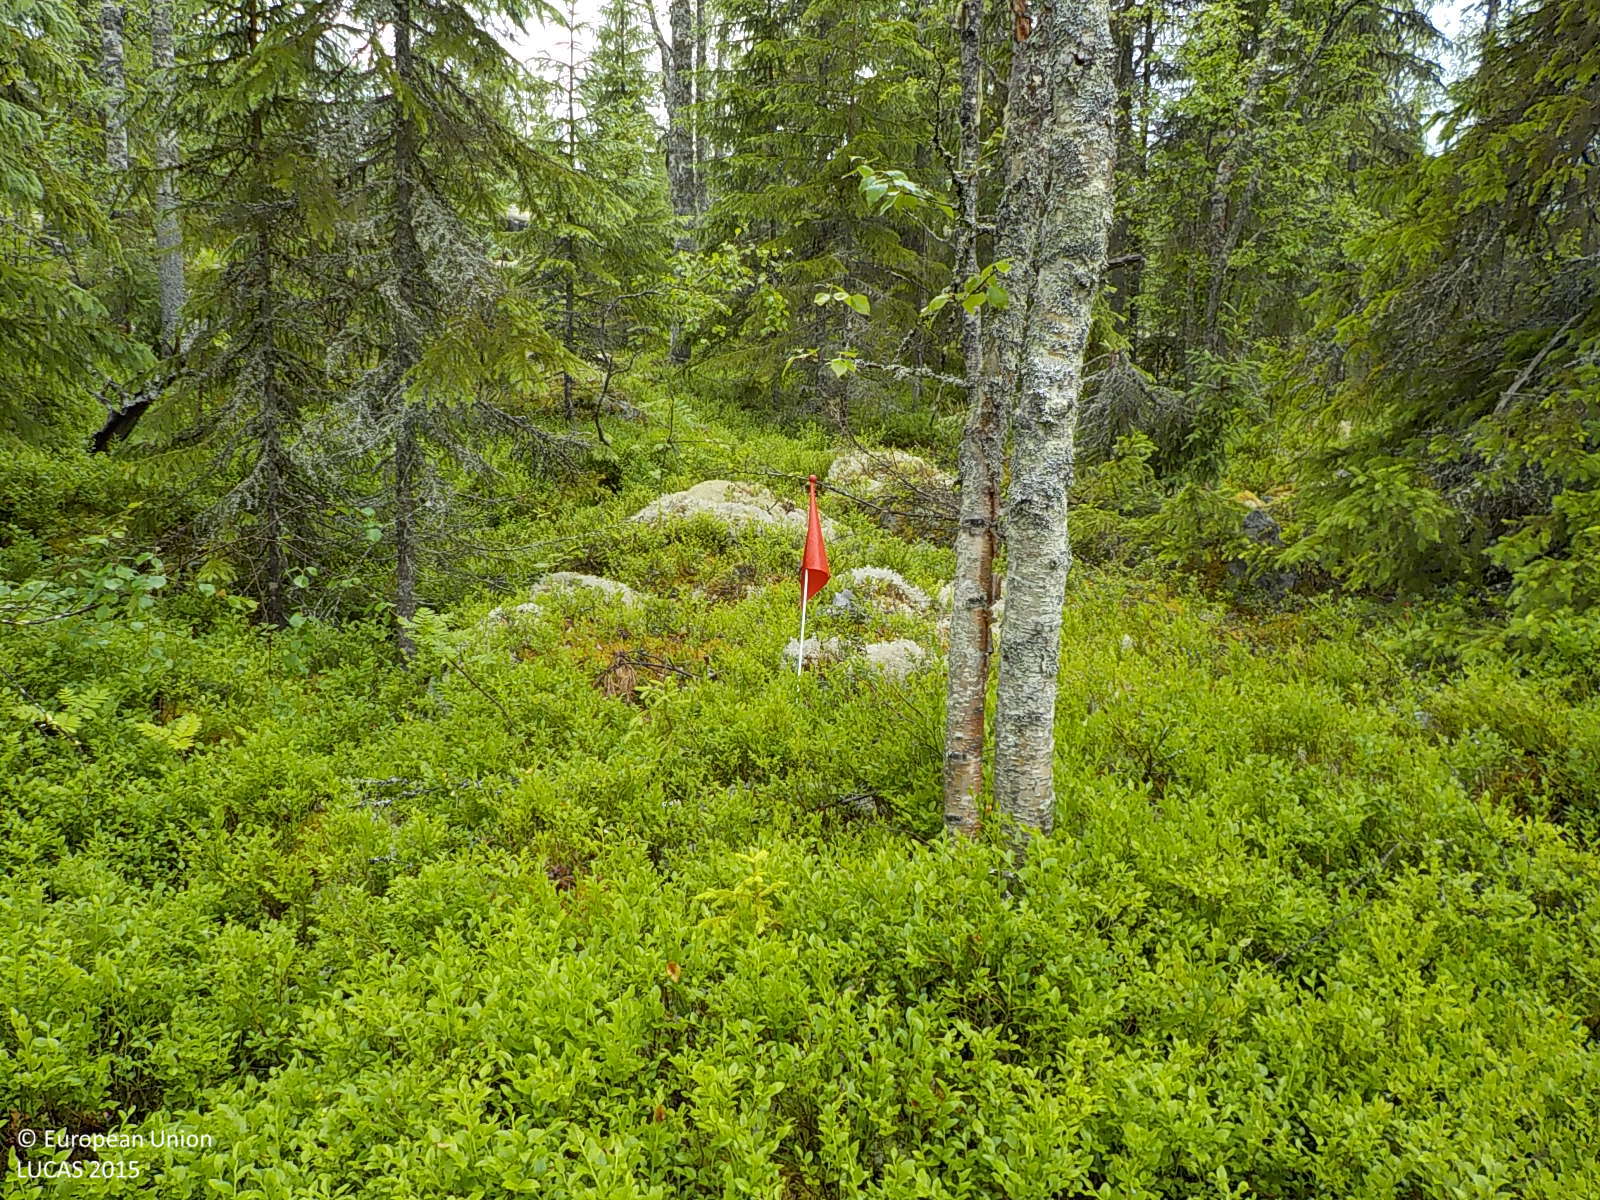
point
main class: Woodland
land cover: Spruce dominated mixed woodland
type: boreal forest
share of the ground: 50 - 75 %
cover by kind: coniferous forest trees 45 %, shrubs 30 %, broadleaved forest trees 15 %, lichens and mosses 10 %
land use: Forestry
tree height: > 5 m
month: July
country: SE
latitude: 63.1584
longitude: 18.0567
